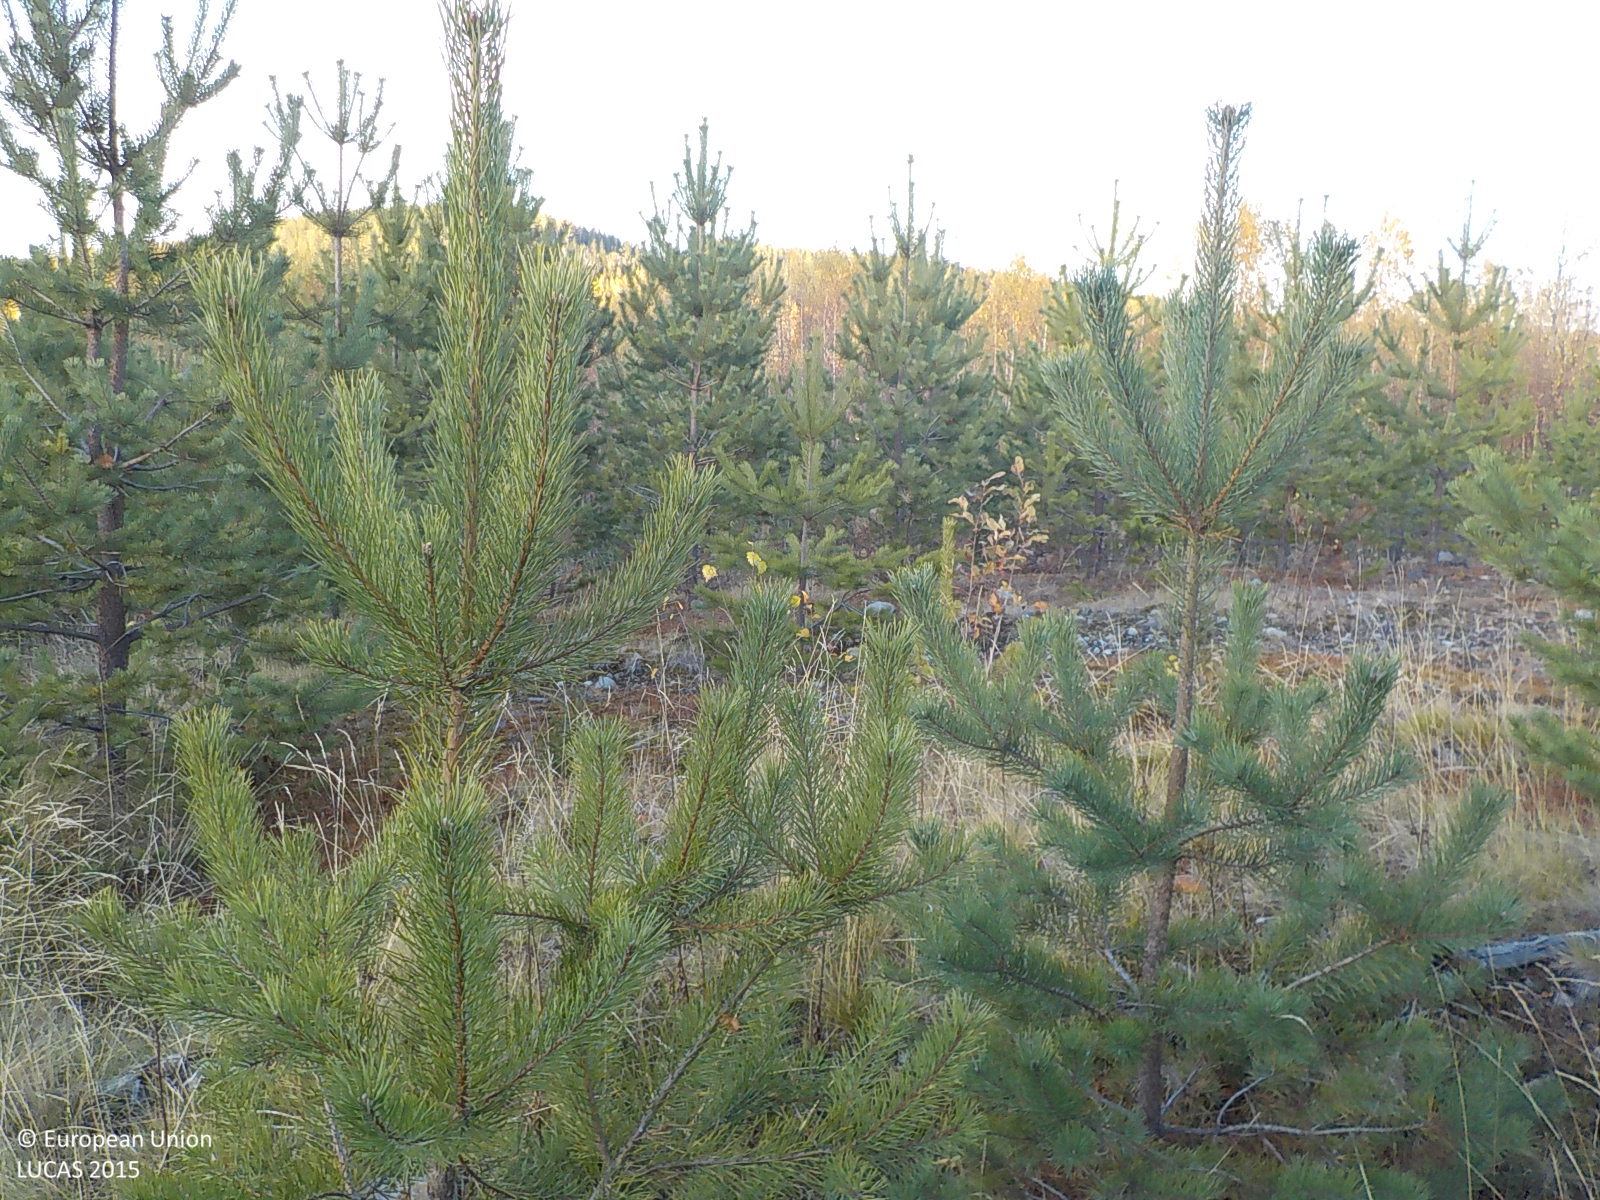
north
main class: Woodland
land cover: Pine dominated coniferous woodland
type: boreal forest
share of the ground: 50 - 75 %
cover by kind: coniferous forest trees 60 %, herbaceous plants 40 %
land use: Forestry
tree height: < 5 m
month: October
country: SE
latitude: 63.2110
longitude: 18.4299
